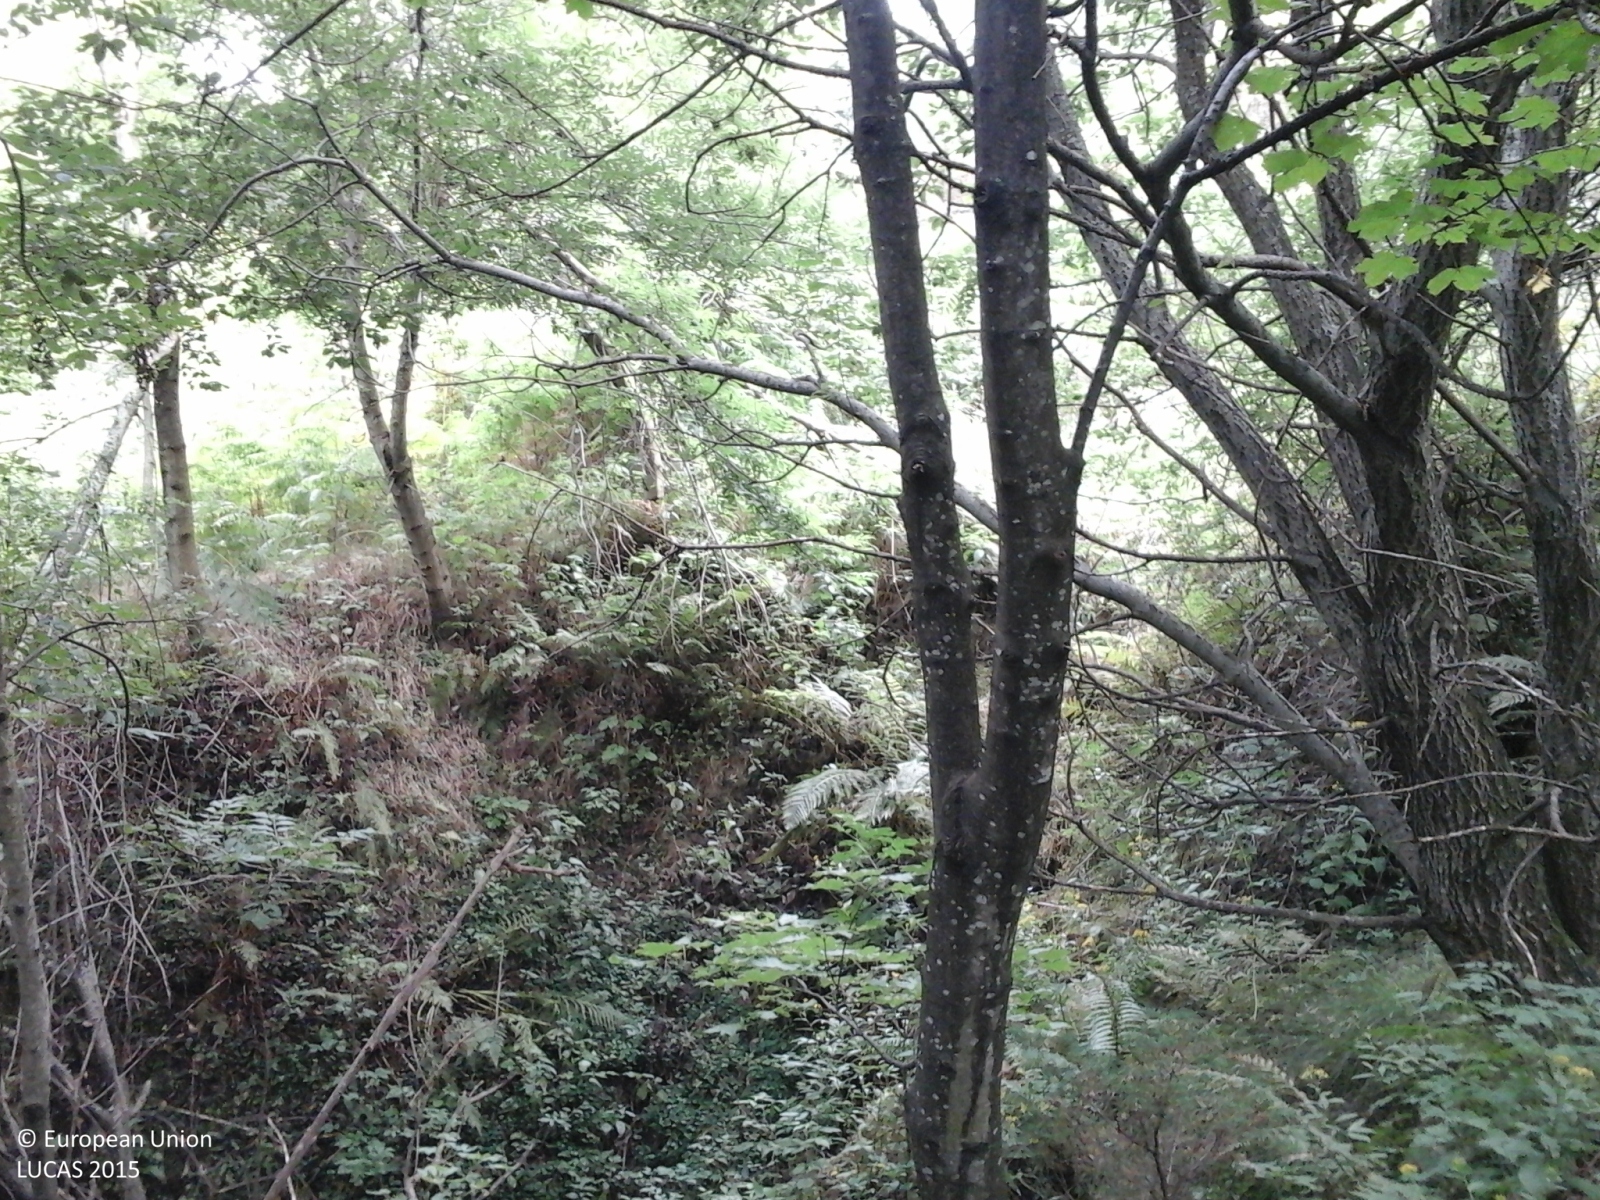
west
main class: Woodland
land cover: Broadleaved woodland
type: mountainous beech forest
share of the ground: > 75 %
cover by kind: broadleaved forest trees 80 %, coniferous forest trees 10 %, herbaceous plants 10 %
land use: Forestry
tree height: > 5 m
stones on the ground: < 10 %
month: August
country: IT
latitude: 46.0773
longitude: 9.1091
